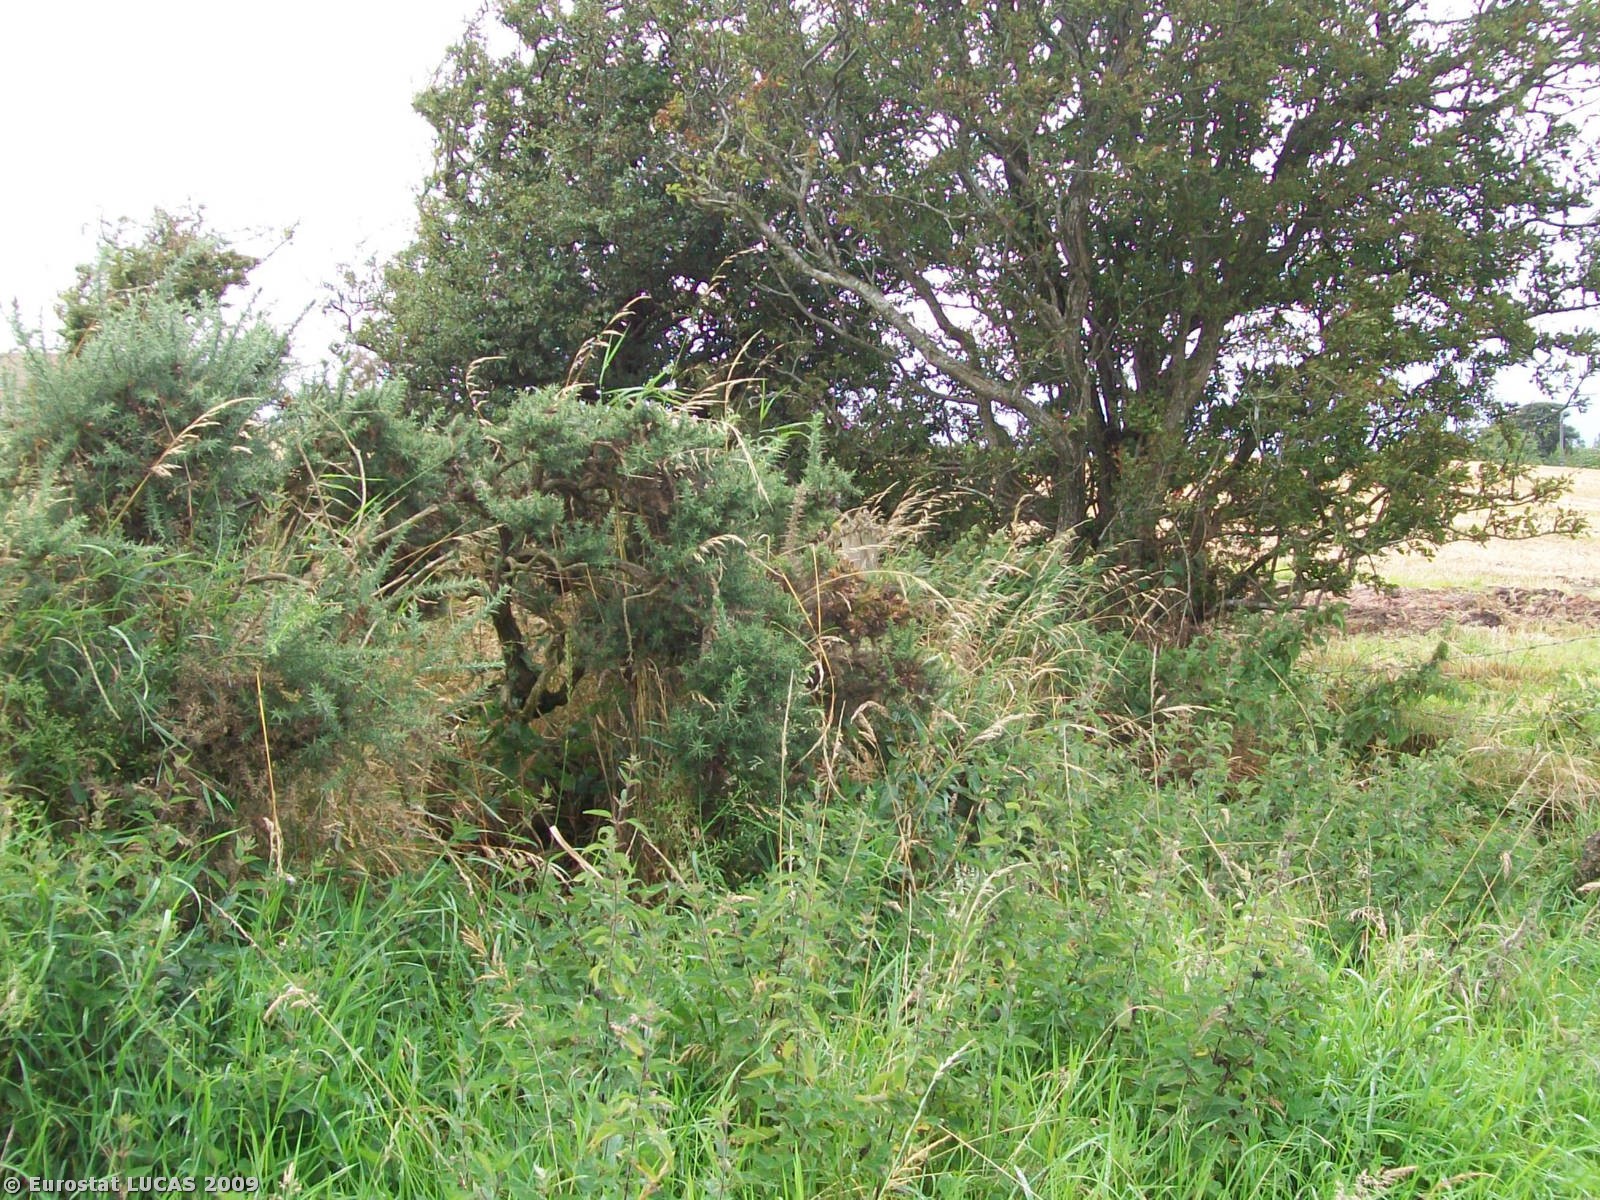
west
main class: Grassland
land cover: Grassland without tree/shrub cover
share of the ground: > 75 %
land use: Agriculture (excluding fallow land and kitchen gardens)
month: August
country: GB
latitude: 54.5200
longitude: -5.9435
